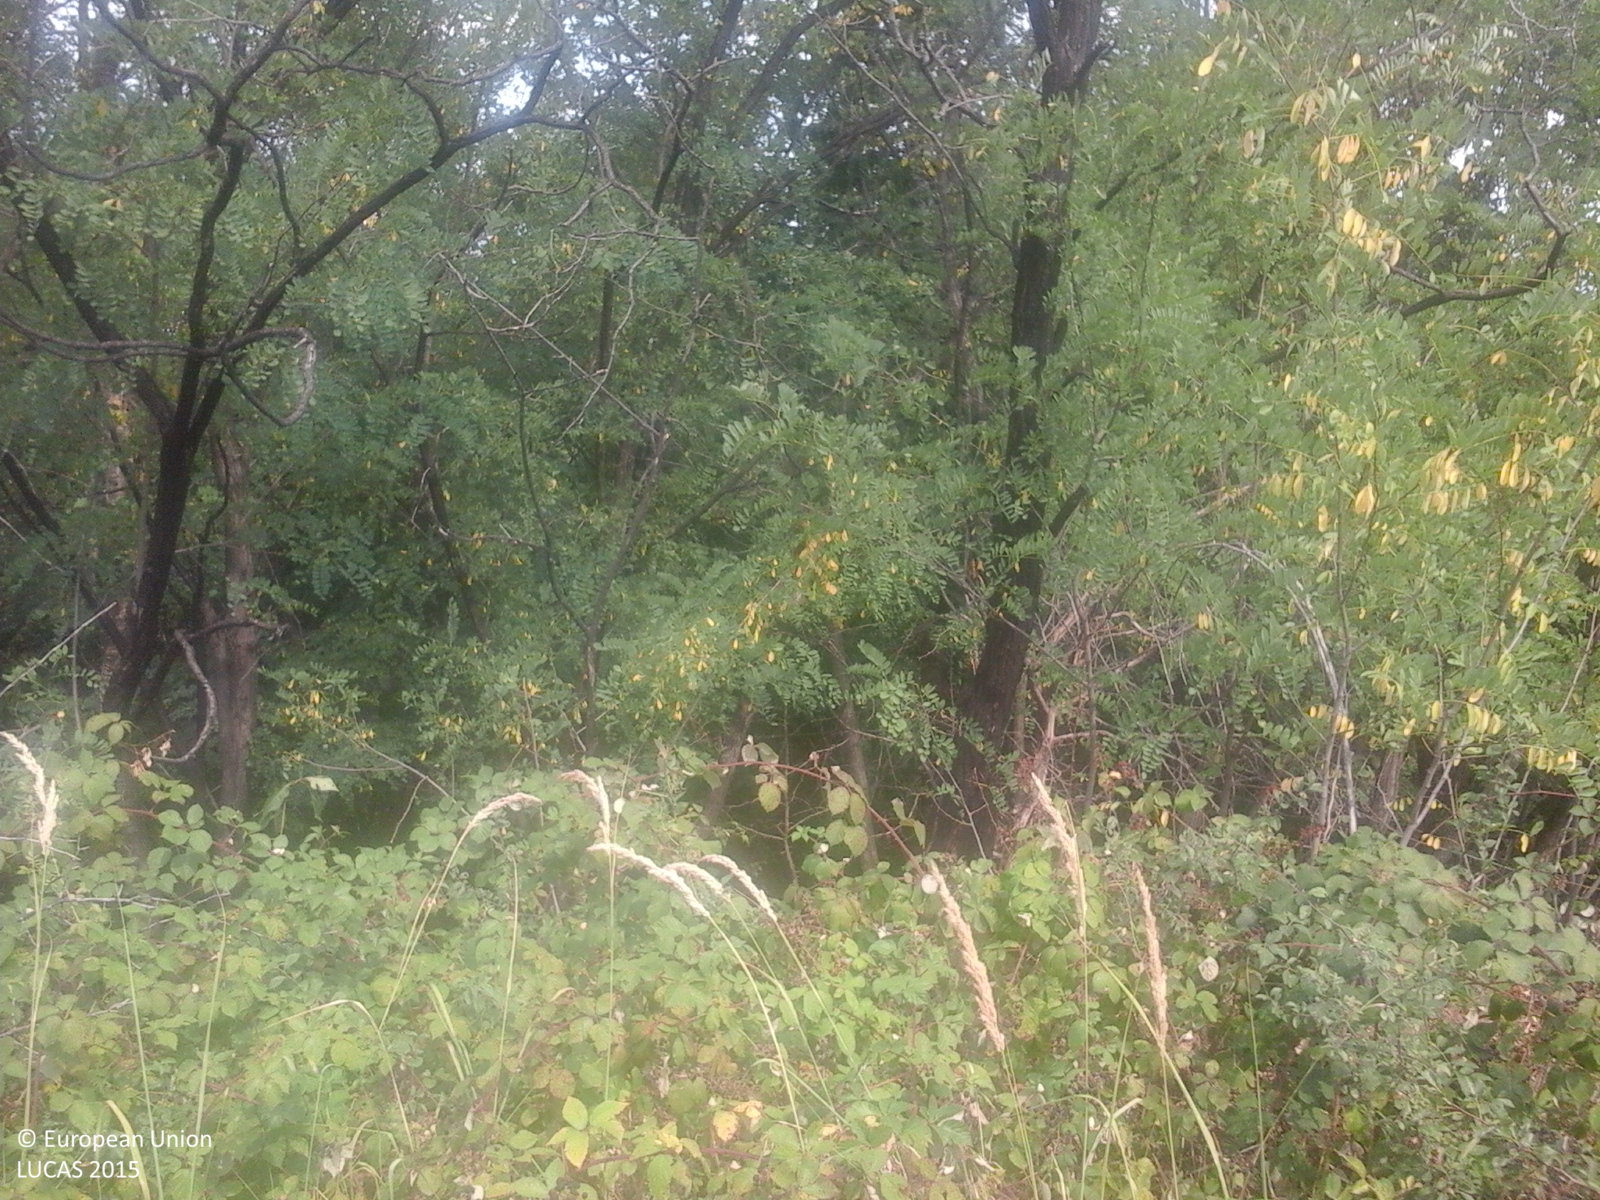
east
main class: Woodland
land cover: Broadleaved woodland
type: exotic forest
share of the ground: > 75 %
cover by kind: broadleaved forest trees 100 %
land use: Forestry
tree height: > 5 m
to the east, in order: Broadleaved woodland; Grassland with sparse tree/shrub cover; Broadleaved woodland
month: August
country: RO
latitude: 44.8601
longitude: 23.7147
